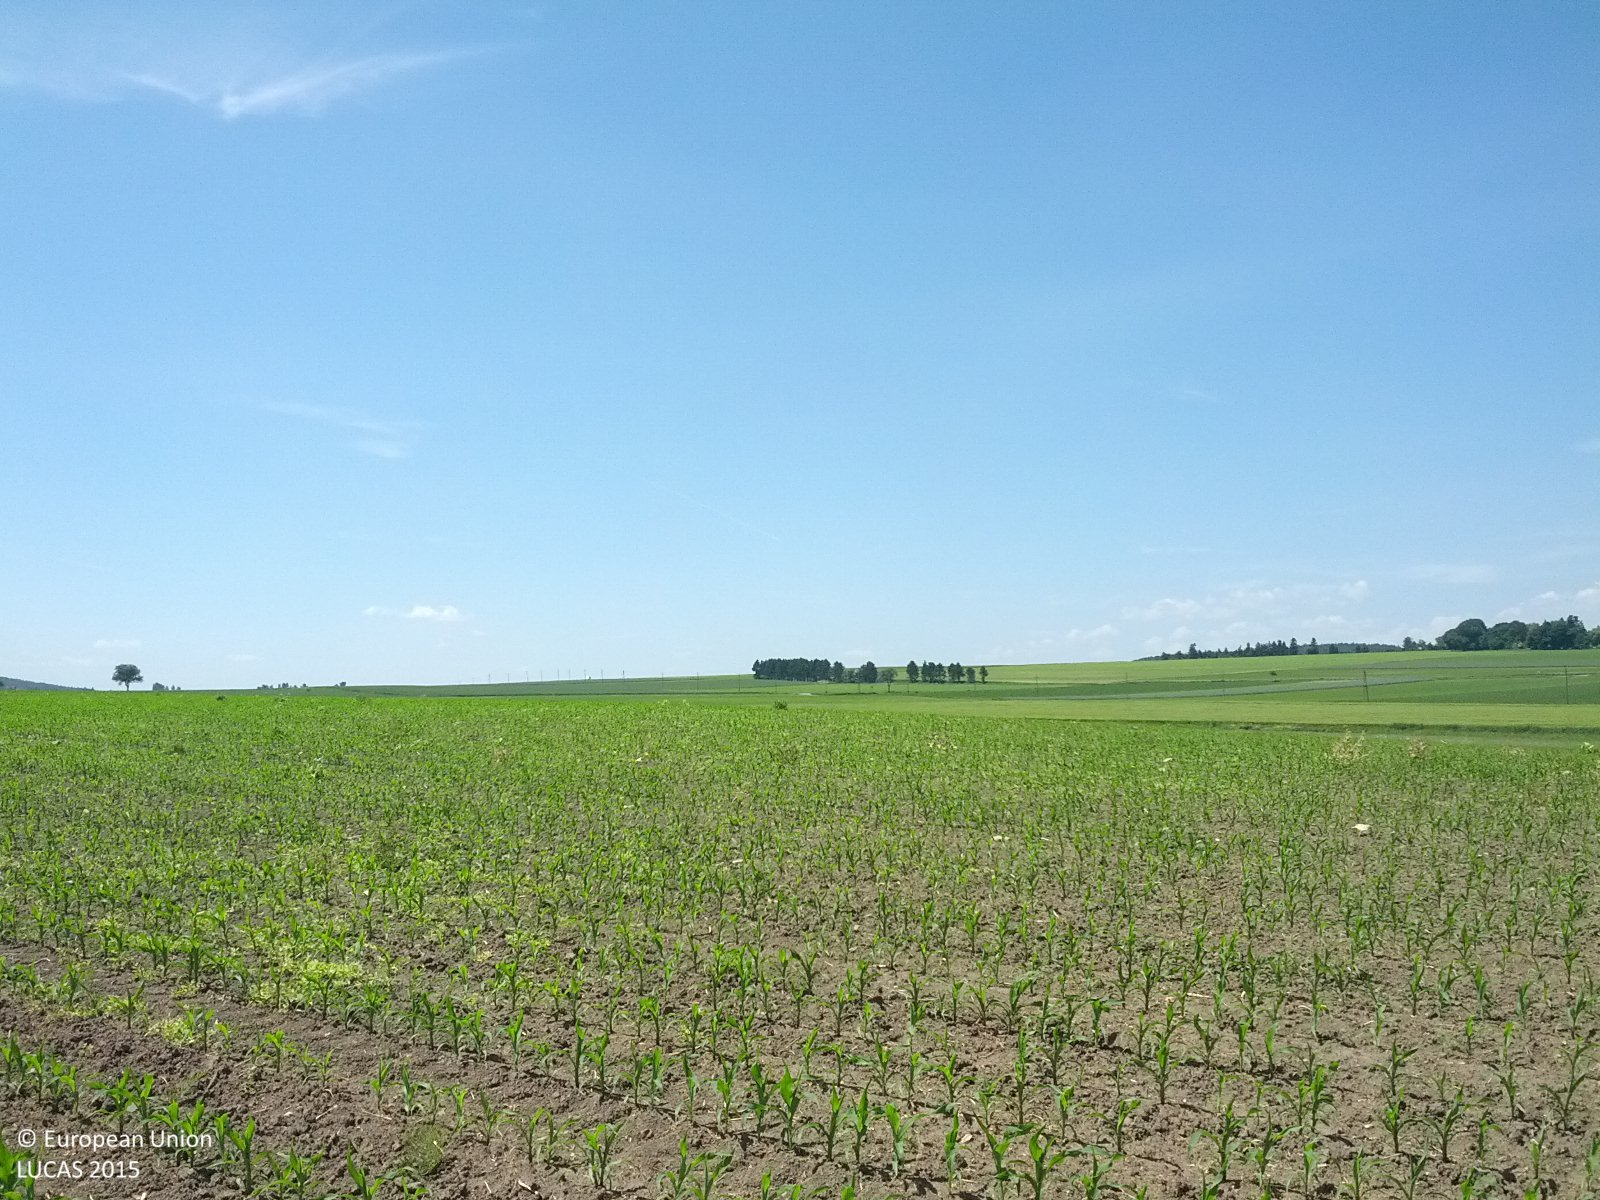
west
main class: Cropland
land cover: Maize
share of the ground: < 10 %
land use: Agriculture (excluding fallow land and kitchen gardens)
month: June
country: AT
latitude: 48.1942
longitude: 15.8553
